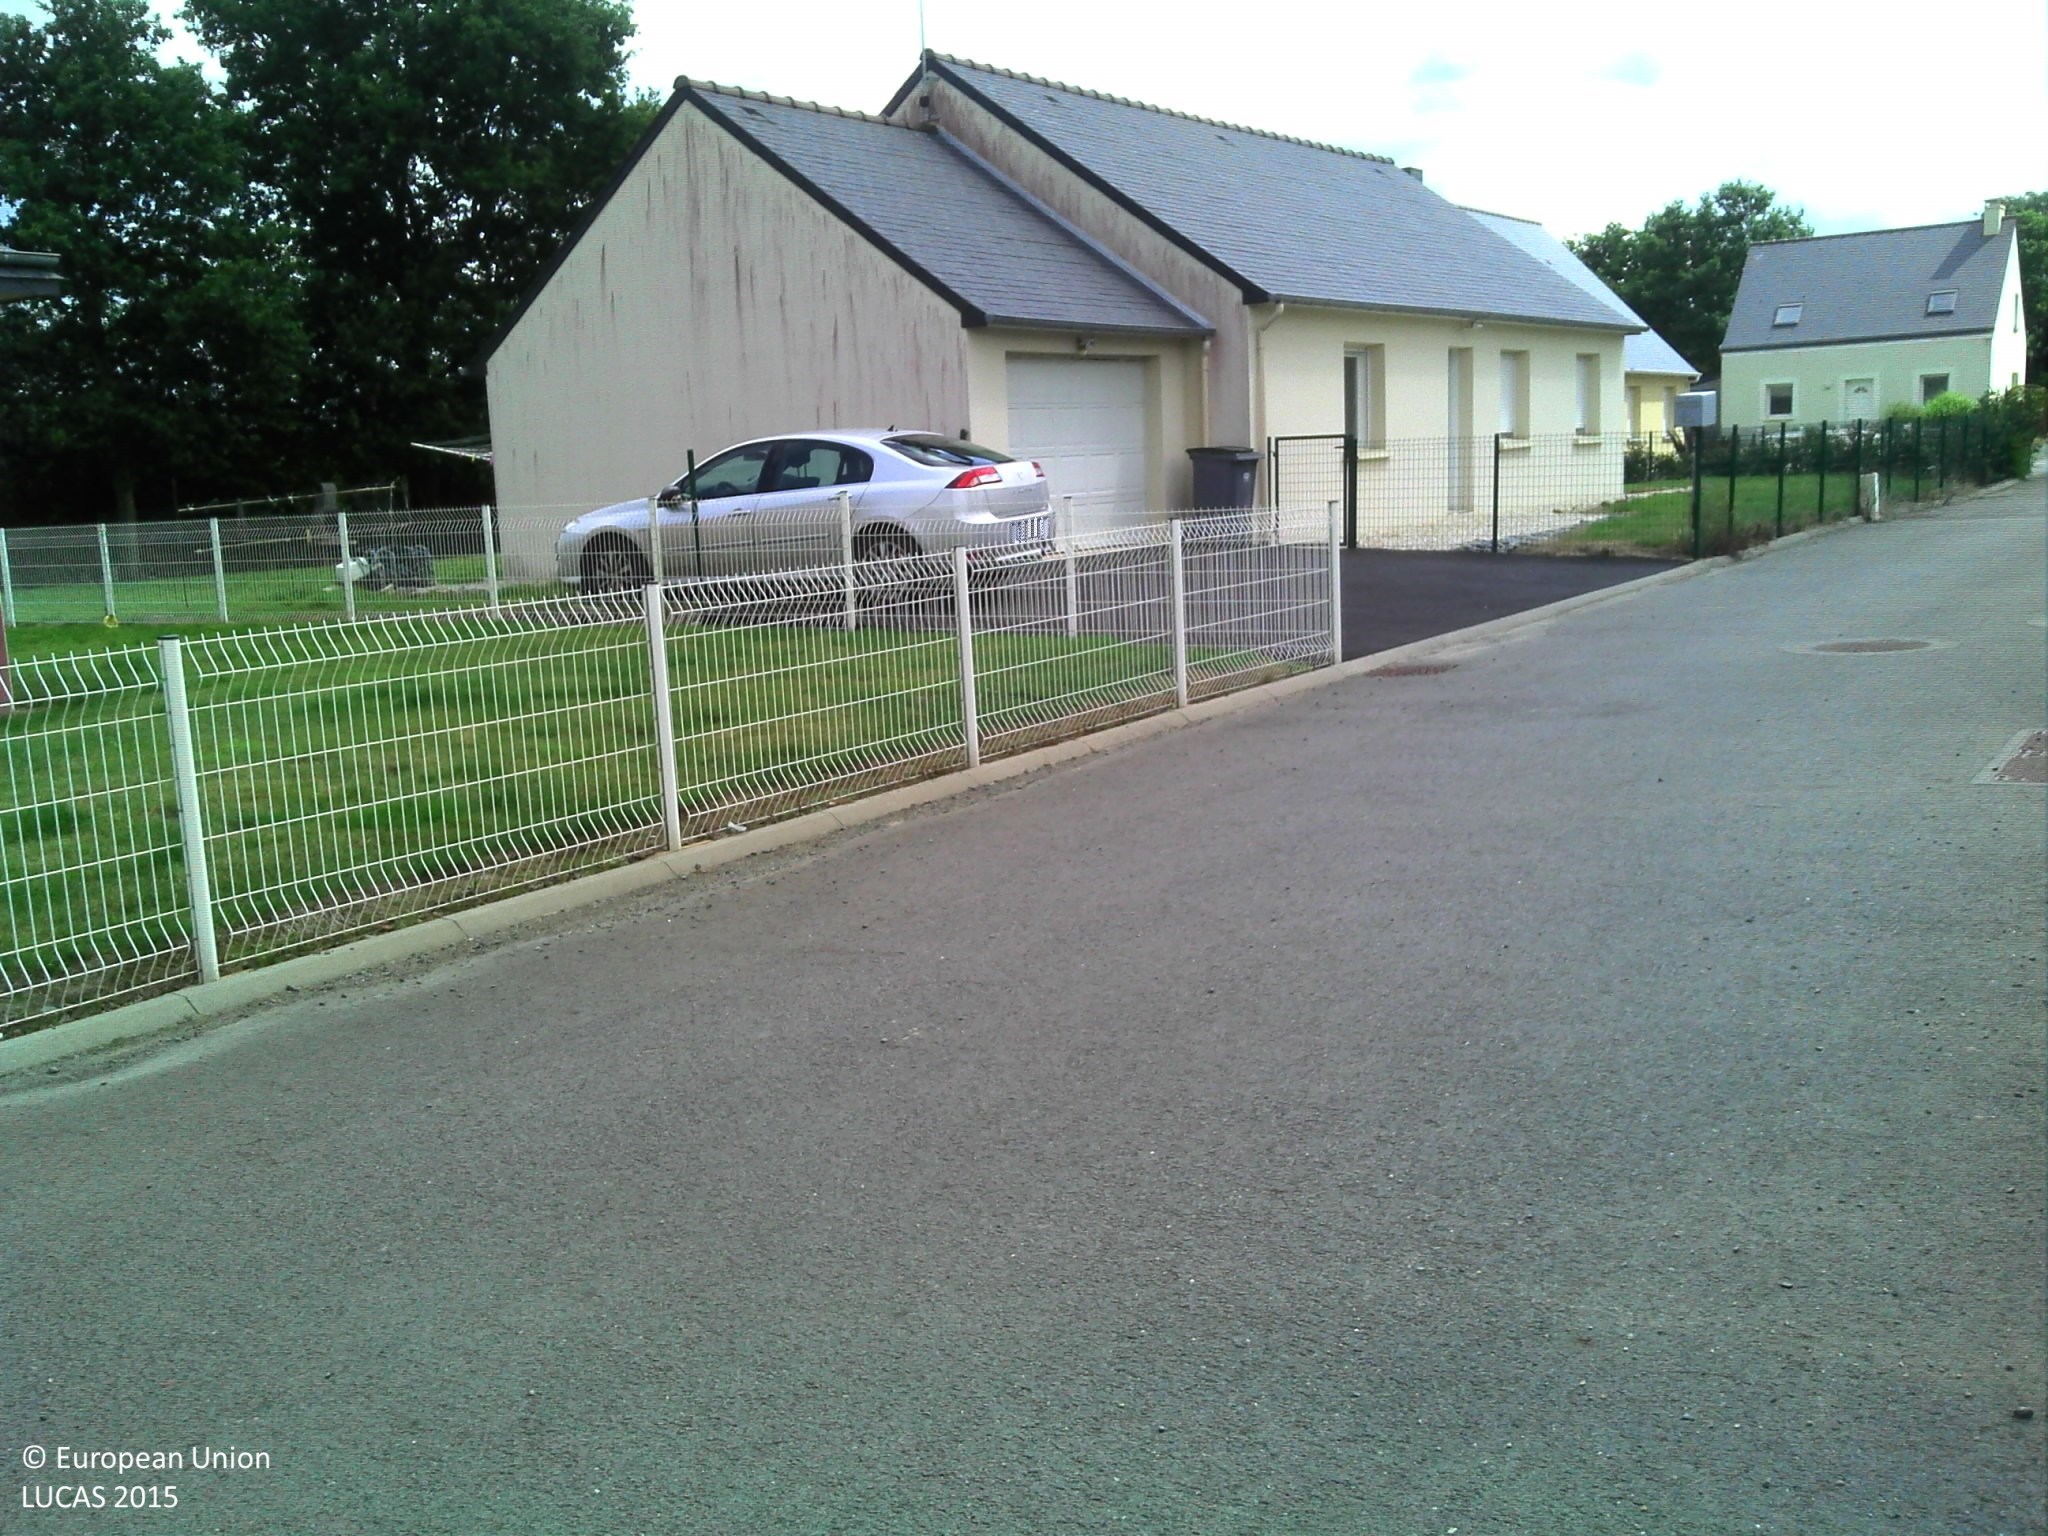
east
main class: Grassland
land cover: Grassland without tree/shrub cover
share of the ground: > 75 %
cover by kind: herbaceous plants 100 %
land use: Residential
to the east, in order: Grassland without tree/shrub cover; Artificial constructions in urban areas; Broadleaved woodland; Grassland without tree/shrub cover
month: August
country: FR
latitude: 48.6149
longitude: -3.1629
